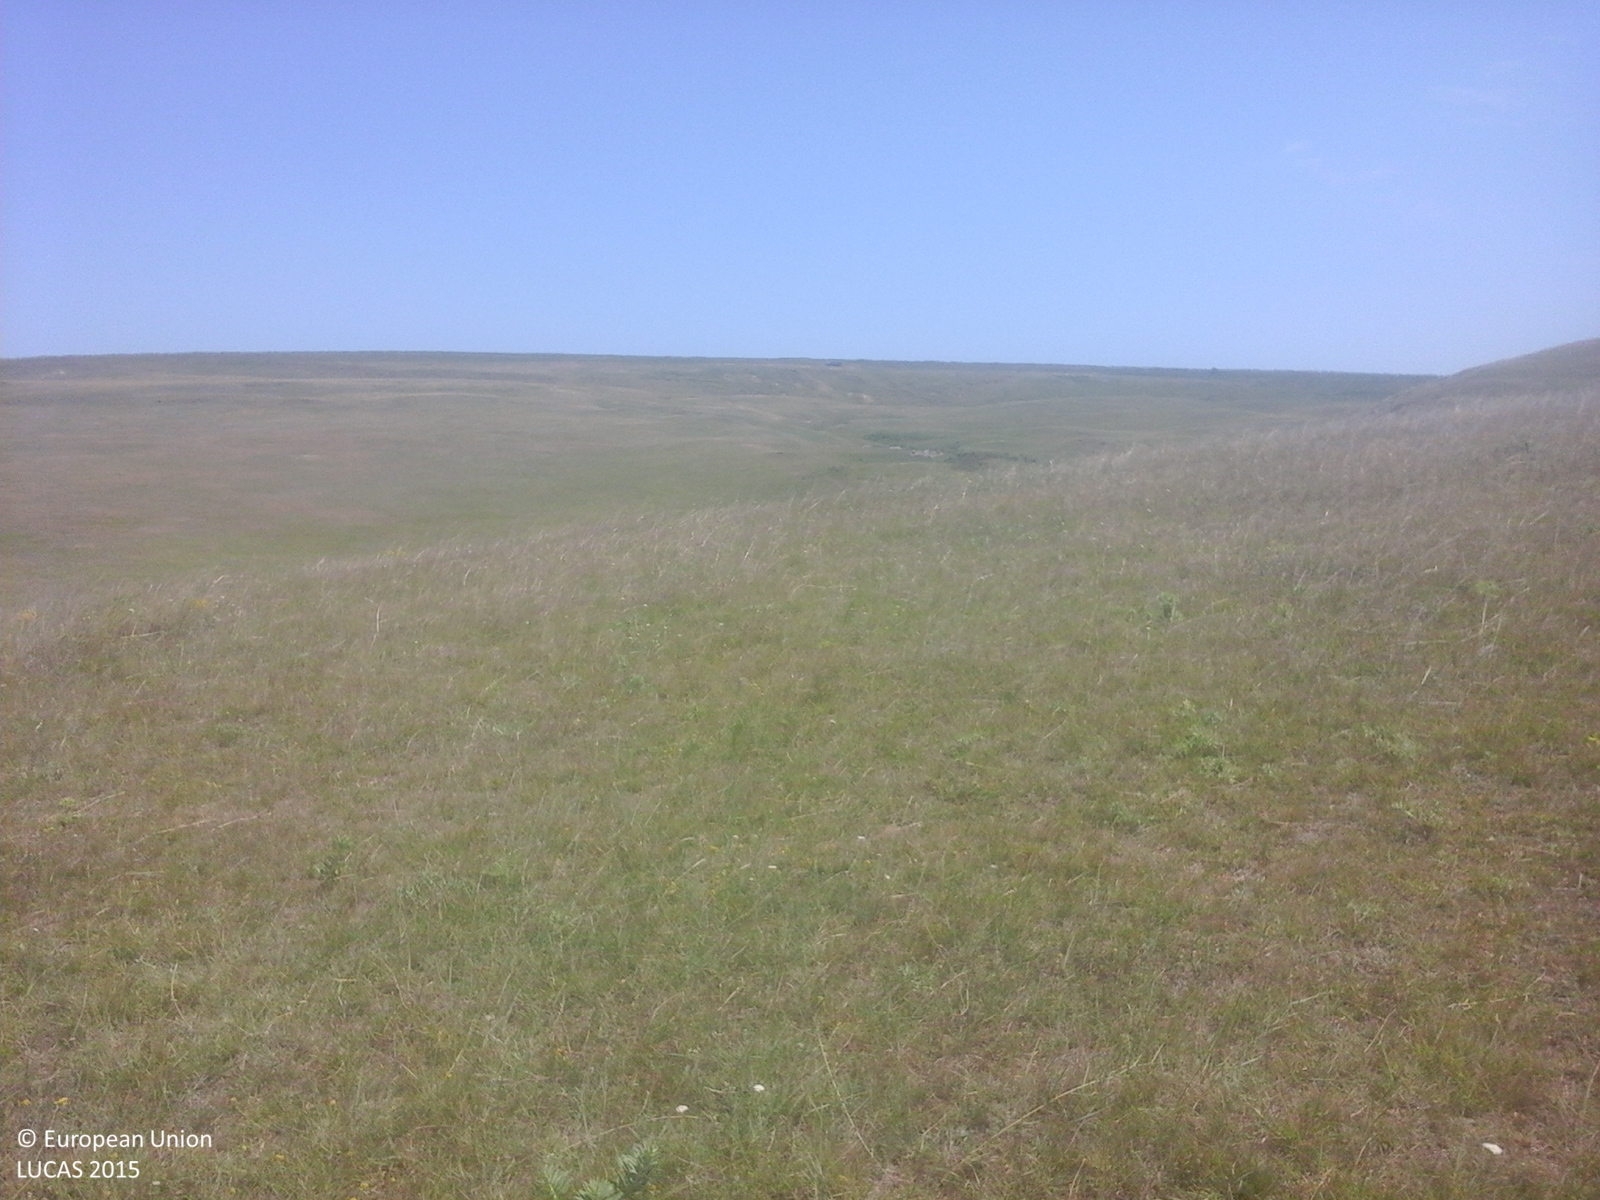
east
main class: Grassland
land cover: Grassland without tree/shrub cover
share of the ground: > 75 %
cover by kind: herbaceous plants 100 %
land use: Agriculture (excluding fallow land and kitchen gardens)
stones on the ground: < 10 %
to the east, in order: Grassland without tree/shrub cover
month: June
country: RO
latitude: 46.8871
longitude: 27.5838
